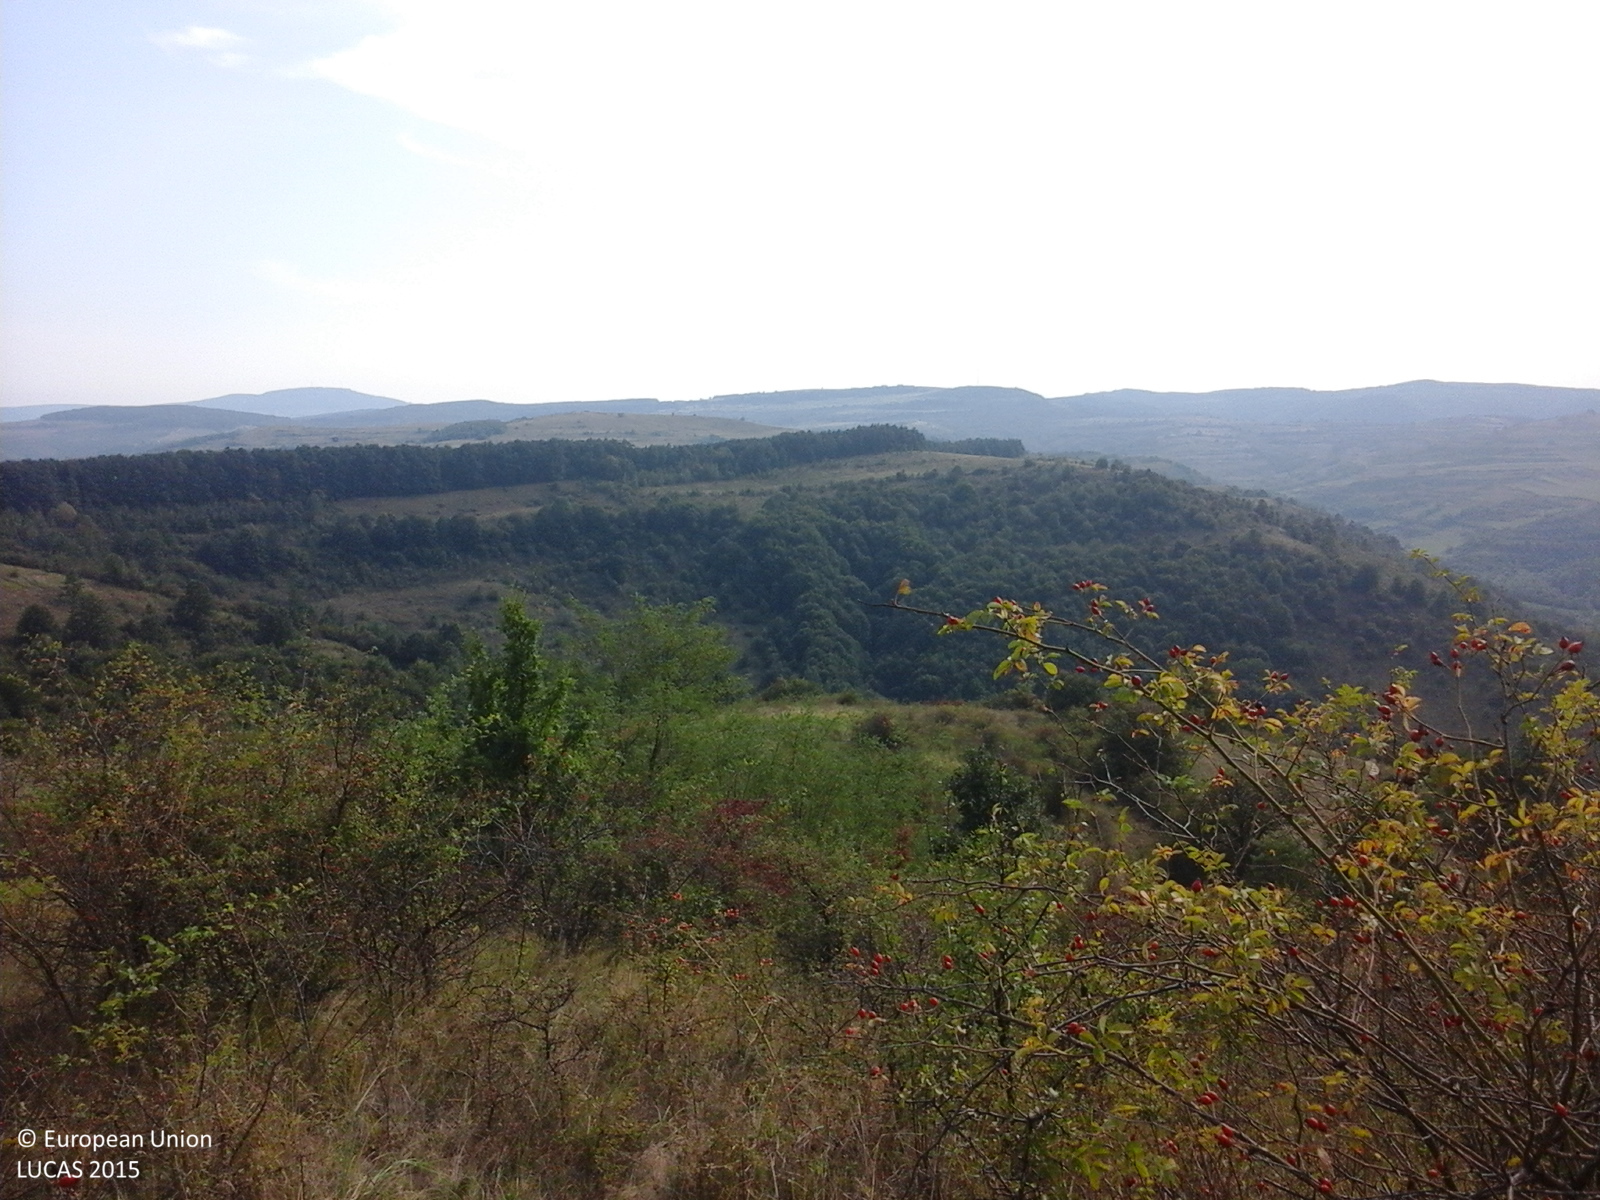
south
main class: Shrubland
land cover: Shrubland without tree cover
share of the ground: > 75 %
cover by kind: shrubs 100 %
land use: Semi-natural and natural areas not in use
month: September
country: RO
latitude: 47.2074
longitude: 23.6332
